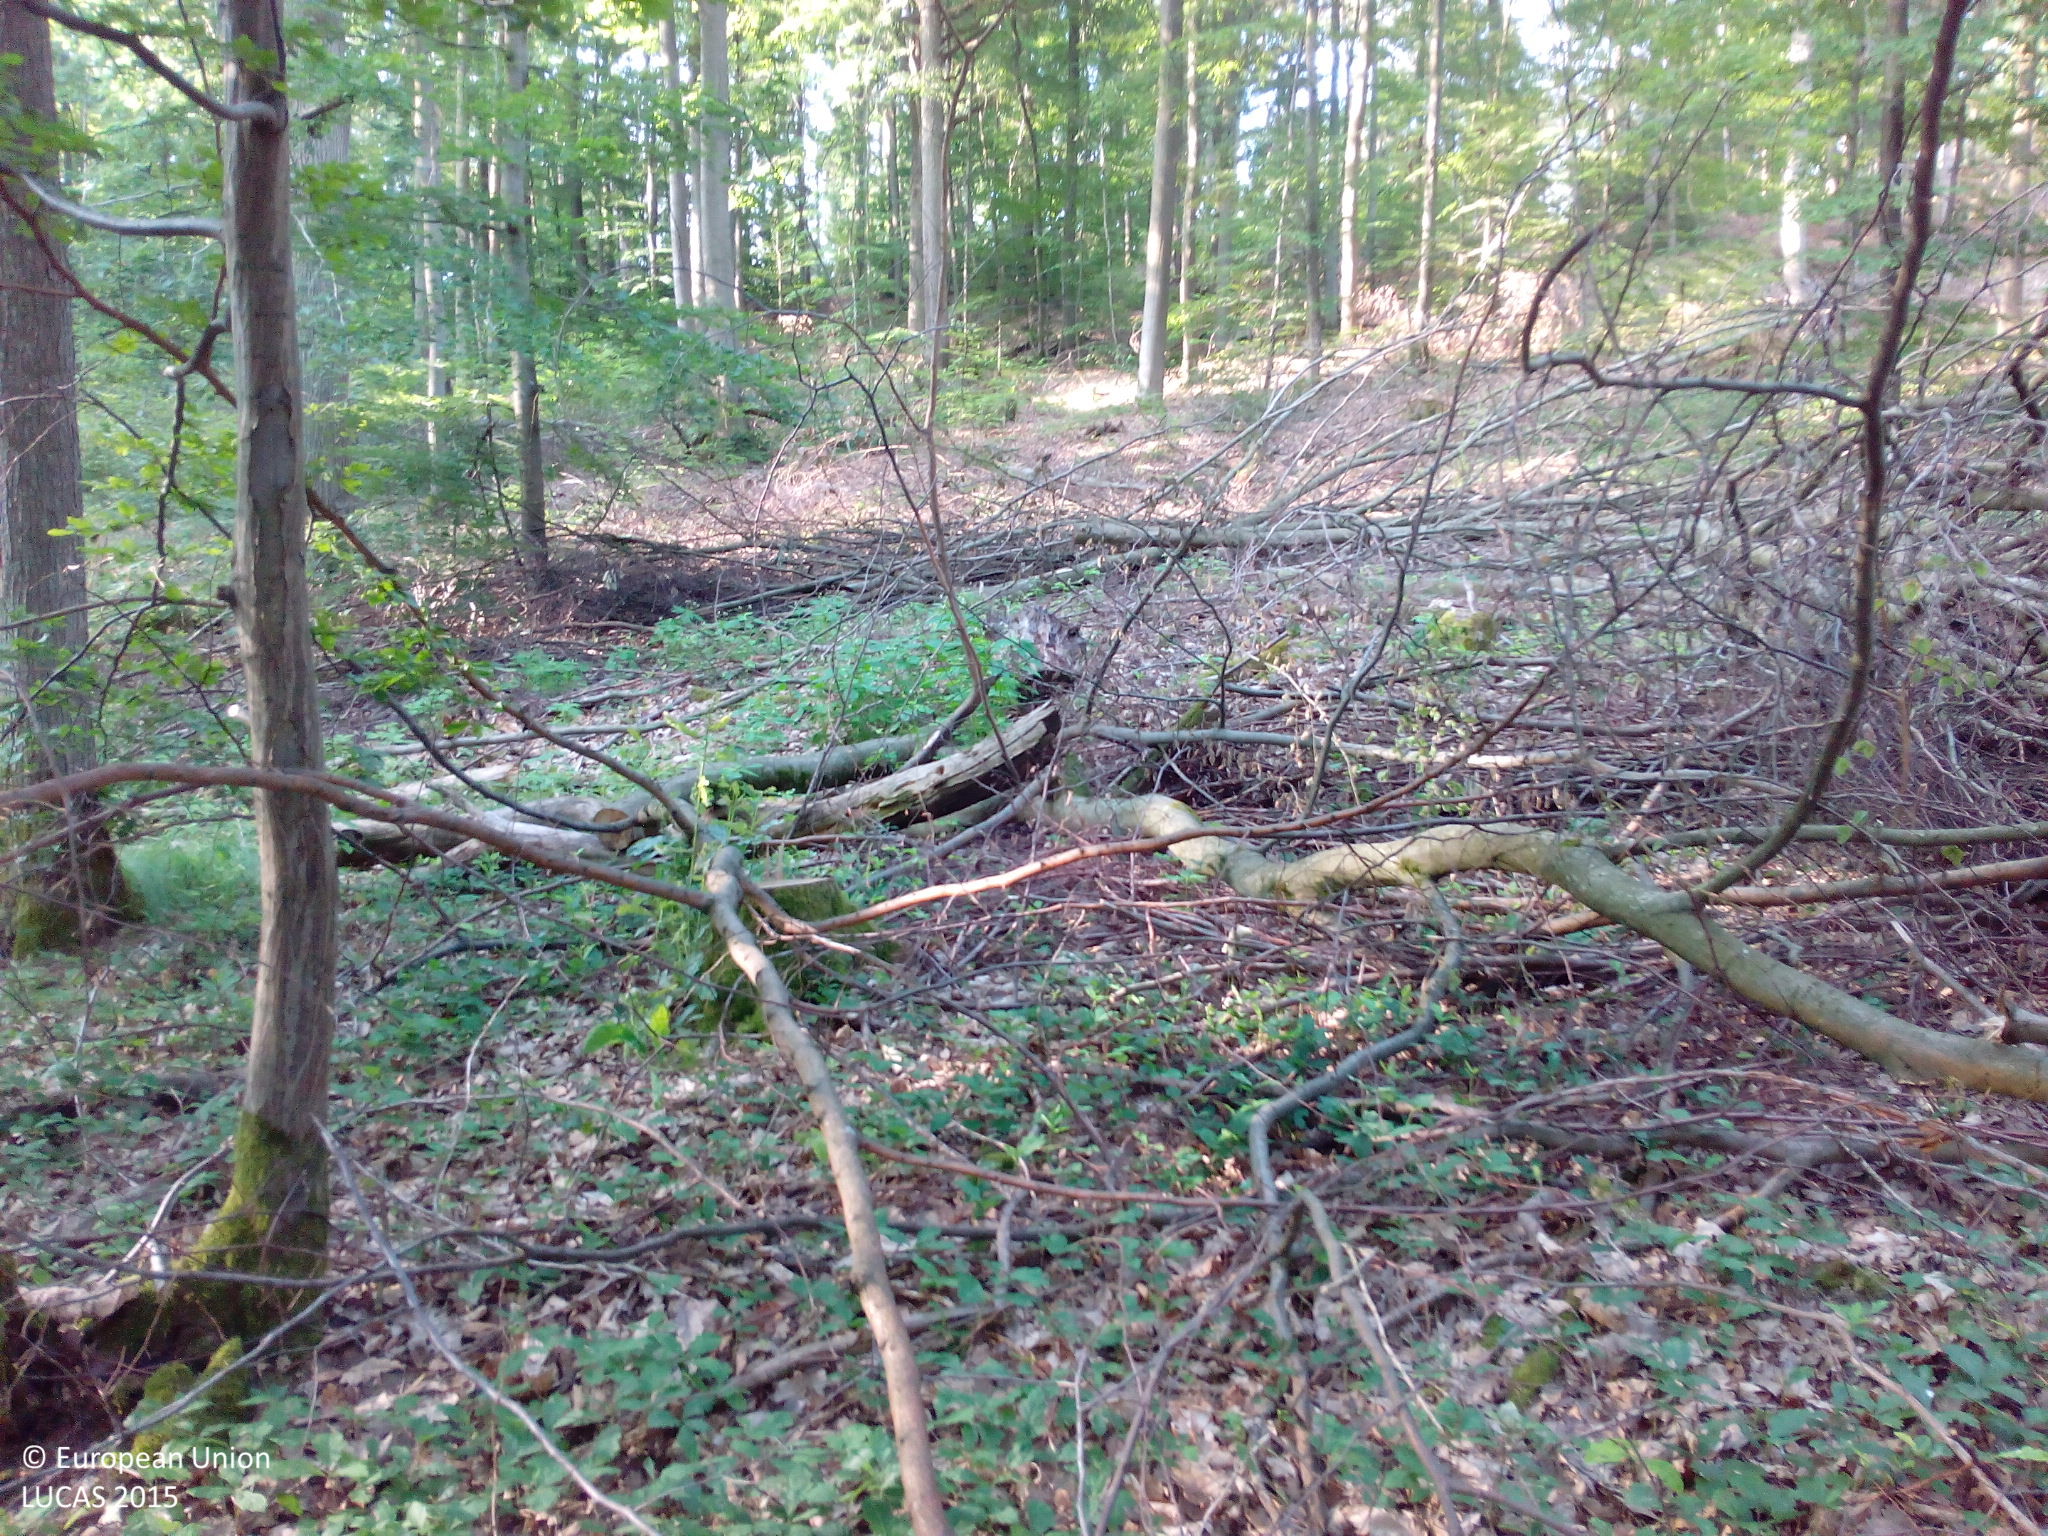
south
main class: Woodland
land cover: Broadleaved woodland
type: mesophytic deciduous forest
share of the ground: > 75 %
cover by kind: broadleaved forest trees 80 %, herbaceous plants 15 %, unconsolidated bare surface 5 %
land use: Forestry
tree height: > 5 m
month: July
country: DE
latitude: 49.8389
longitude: 10.9035
